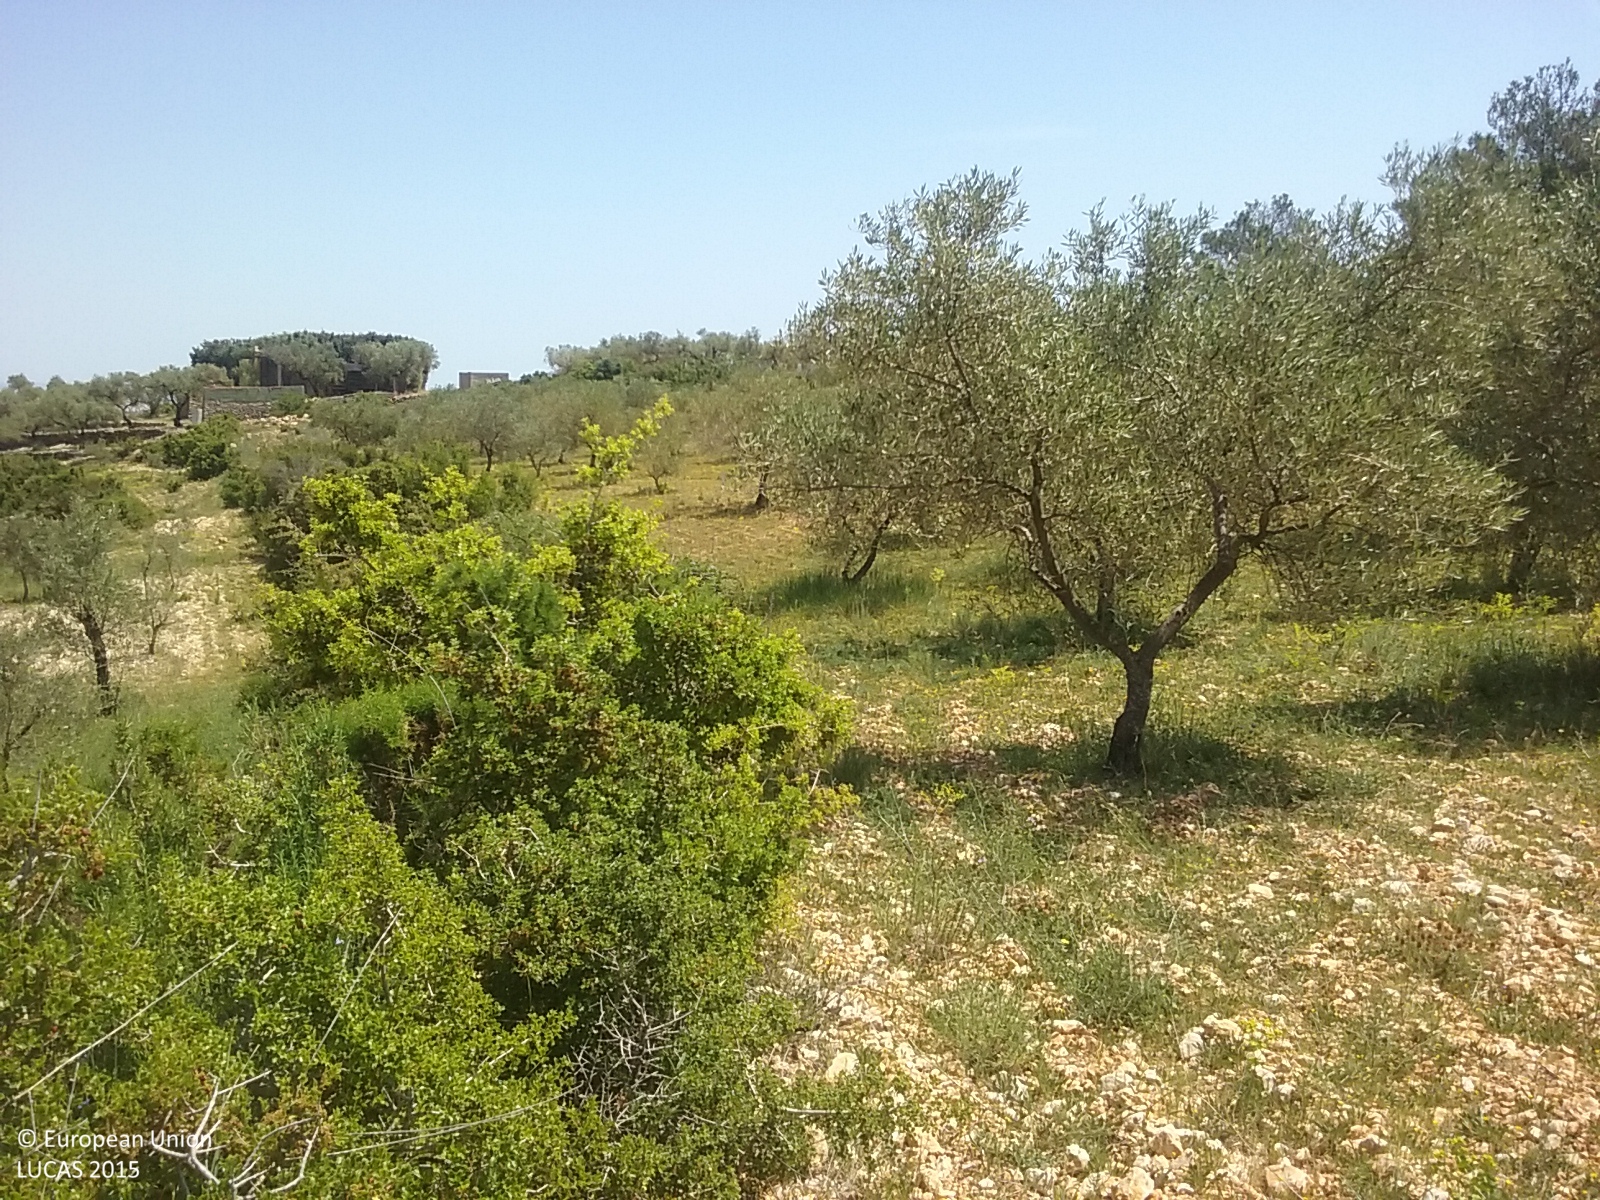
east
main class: Cropland
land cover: Olive groves
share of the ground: 10 - 25 %
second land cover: Other bare soil
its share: > 75 %
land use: Agriculture (excluding fallow land and kitchen gardens)
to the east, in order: Shruby margins; Olive groves; Other bare soil; Abandoned hedges; Dry stone walls; Olive groves; Dry stone walls; Olive groves; Dry stone walls; Permanent industrial crops; Dry stone walls; Olive groves; Dry stone walls; Shrubland with sparse tree cover; Dry stone walls; Shrubland with sparse tree cover; Dry stone walls; Permanent industrial crops; Dry stone walls; Permanent industrial crops; Dry stone walls; Olive groves; Dry stone walls; Olive groves; Dry stone walls; Olive groves; Dry stone walls; Olive groves; Dry stone walls; Permanent industrial crops; Dry stone walls; Olive groves; Dry stone walls; Olive groves; Dry stone walls; Olive groves; Dry stone walls; Olive groves; Dry stone walls; Olive groves
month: May
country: ES
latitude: 40.5411
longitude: 0.2069
